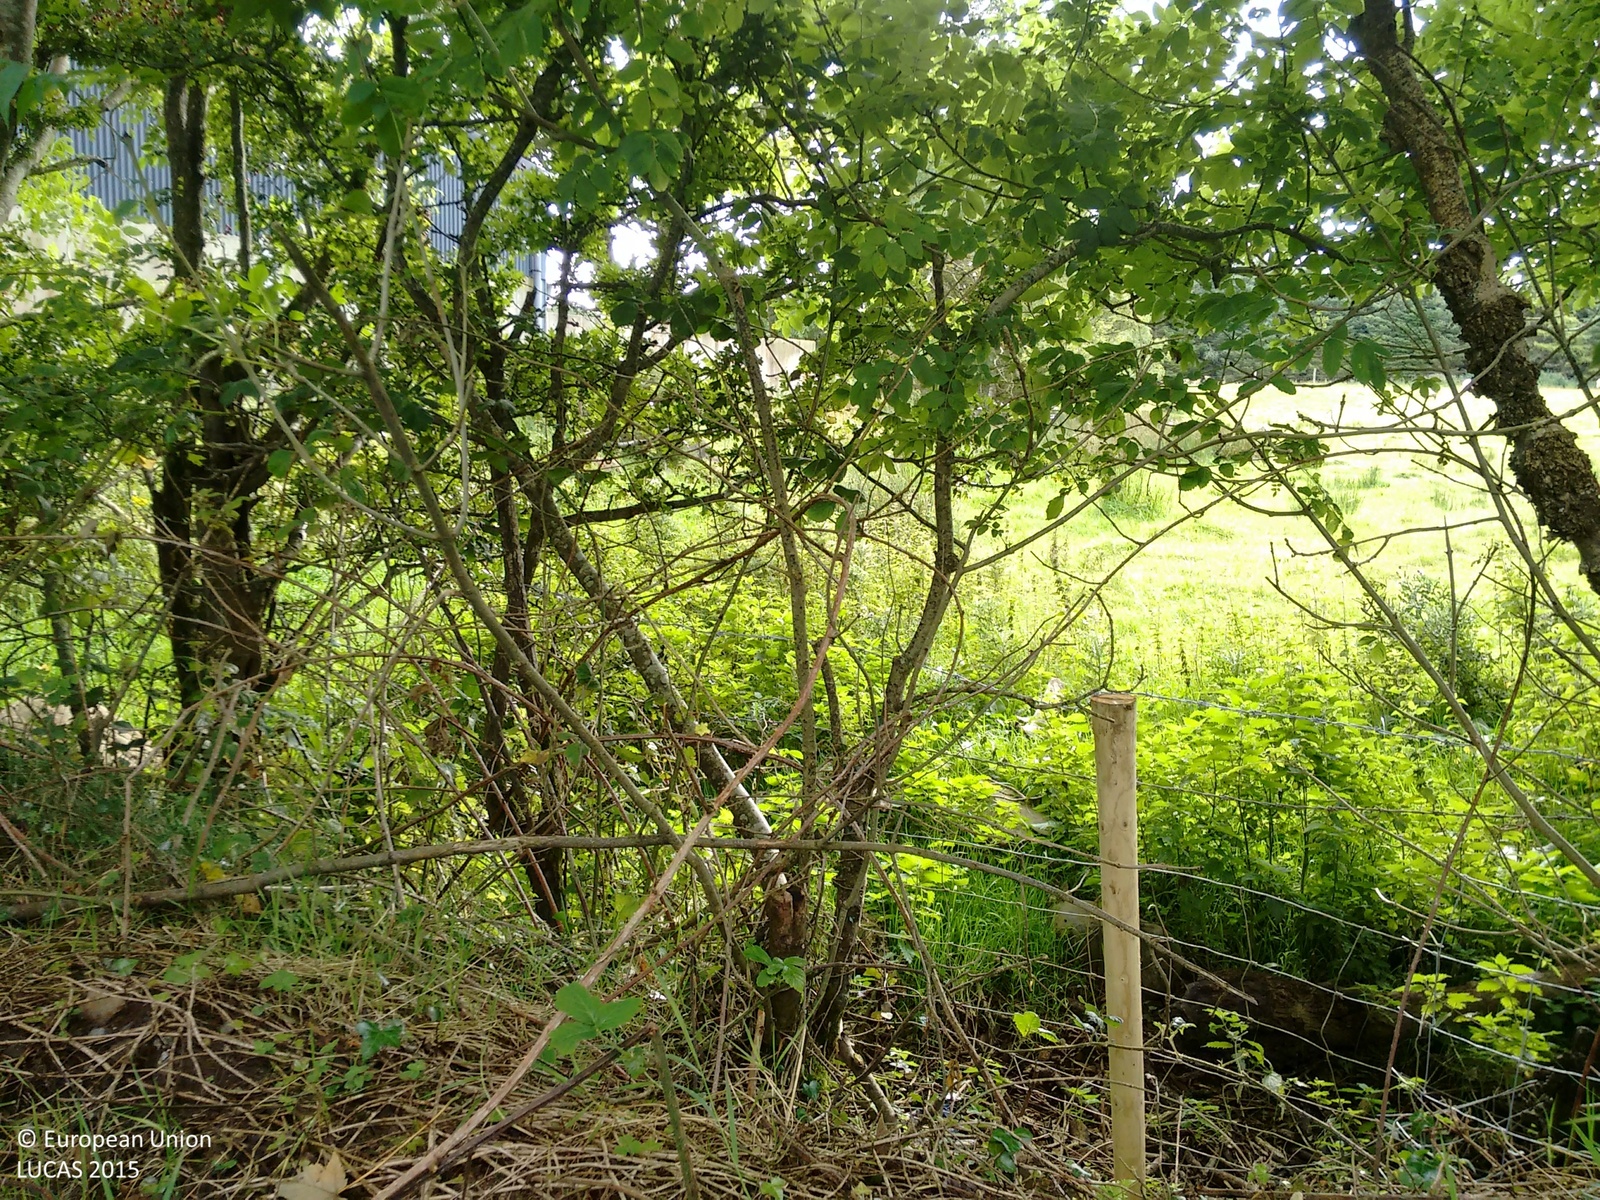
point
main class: Grassland
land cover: Grassland without tree/shrub cover
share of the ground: > 75 %
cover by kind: herbaceous plants 100 %
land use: Agriculture (excluding fallow land and kitchen gardens)
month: September
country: IE
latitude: 55.2247
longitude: -7.2657
